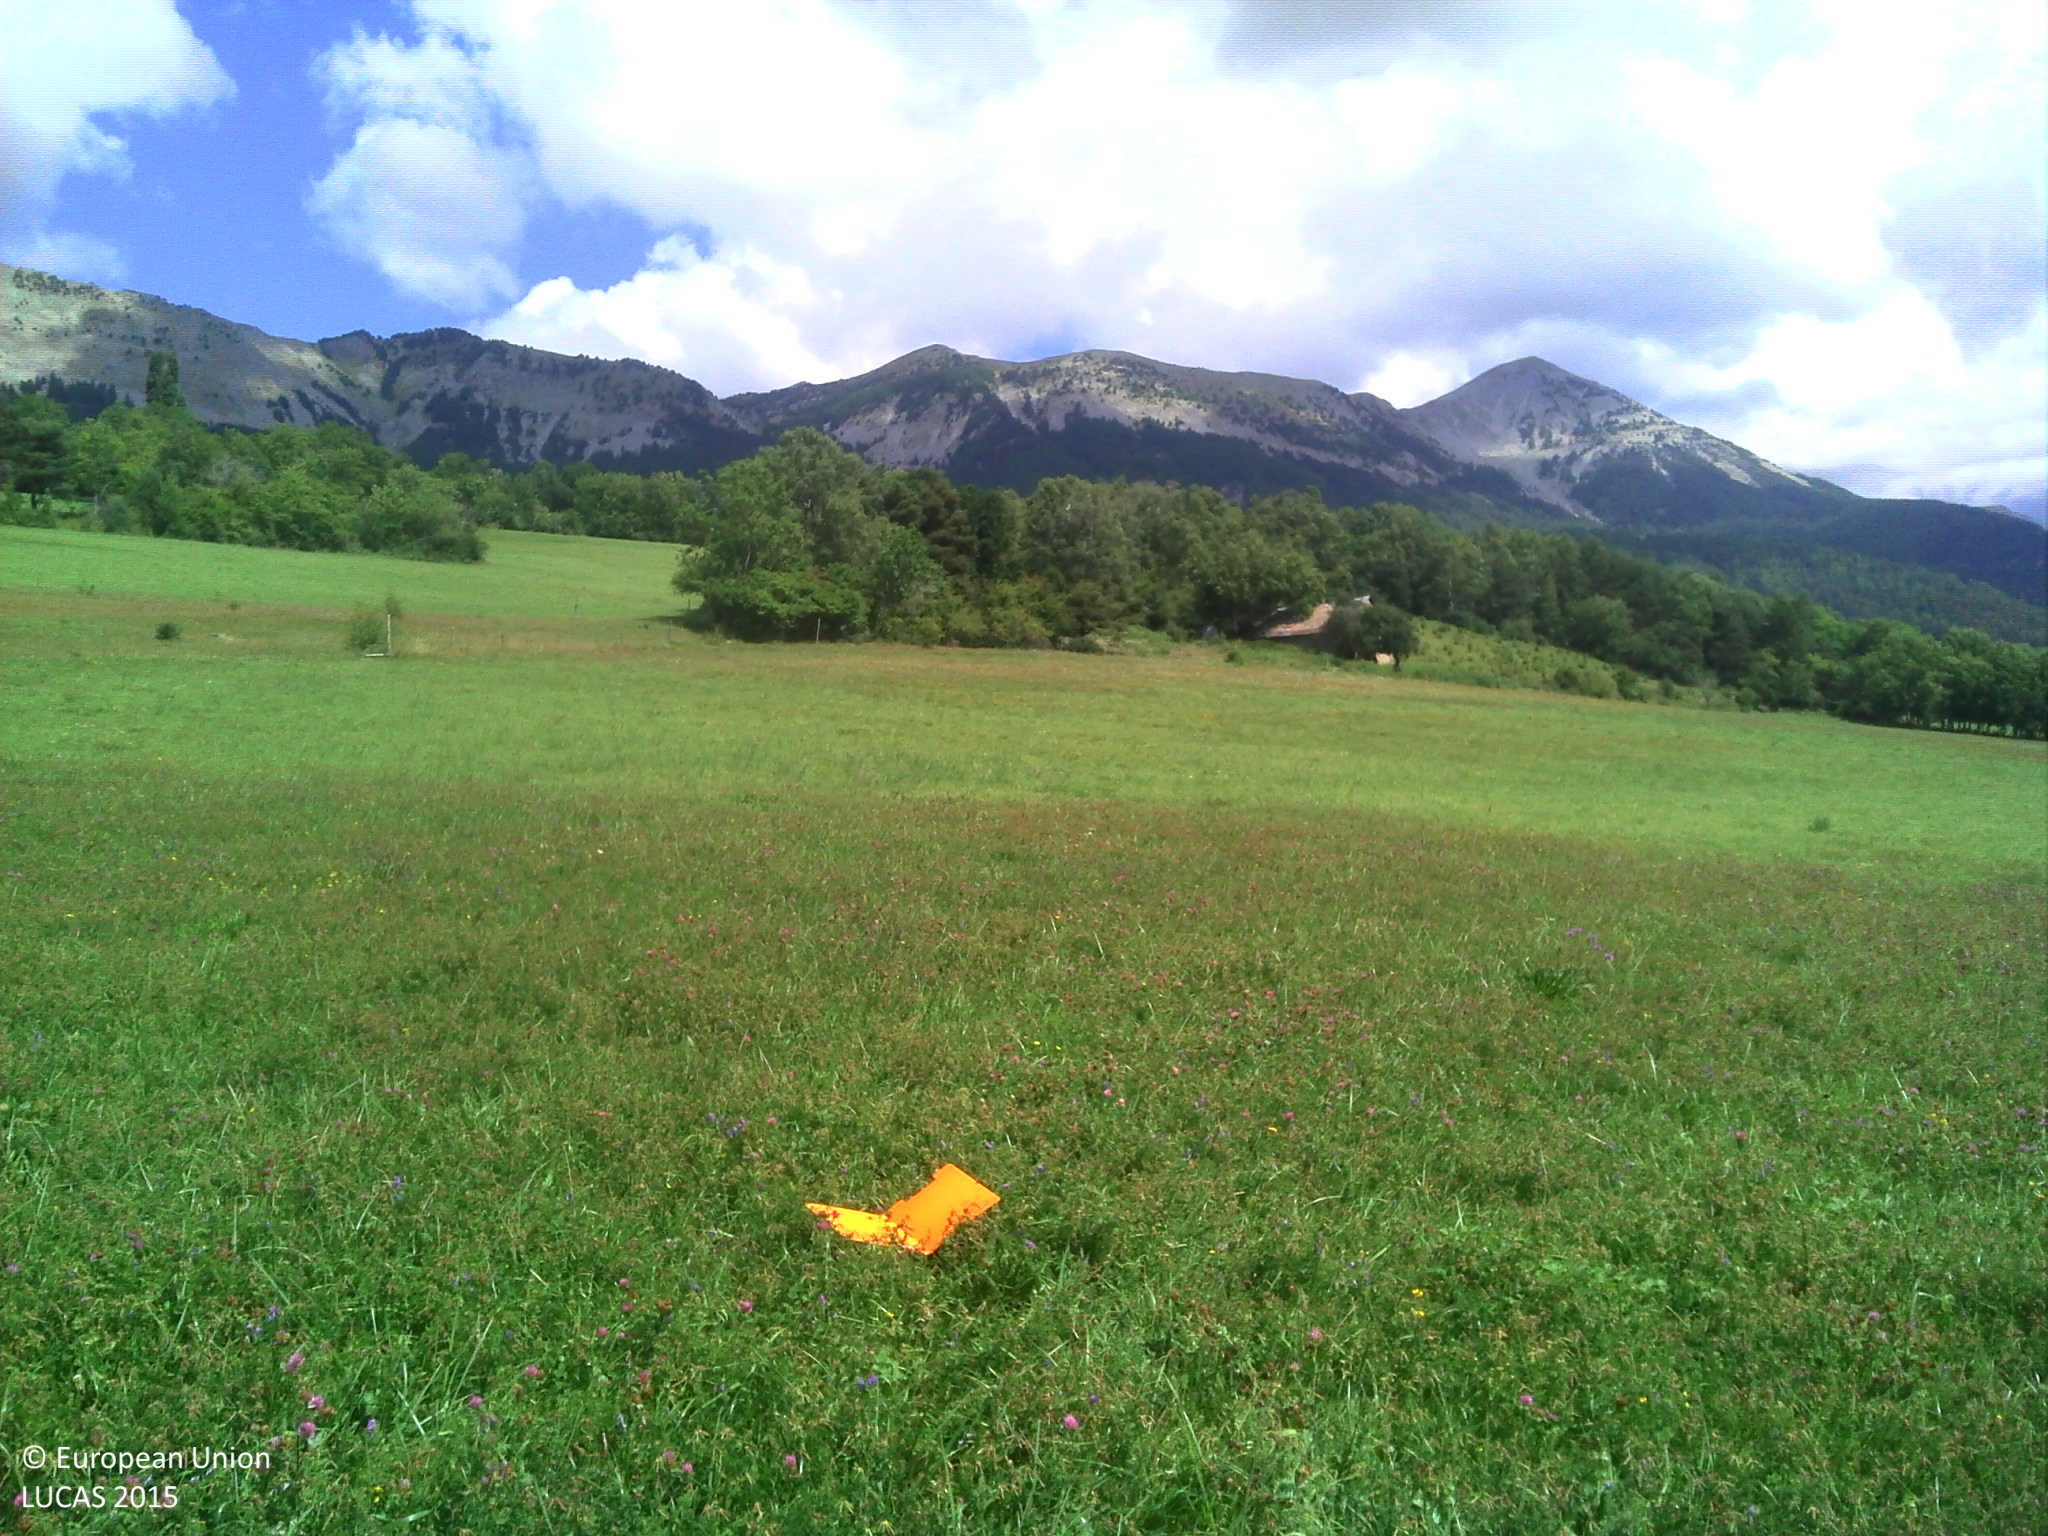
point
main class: Grassland
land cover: Grassland without tree/shrub cover
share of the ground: > 75 %
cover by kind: herbaceous plants 100 %
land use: Agriculture (excluding fallow land and kitchen gardens)
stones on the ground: < 10 %
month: August
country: FR
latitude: 44.3768
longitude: 6.3546
